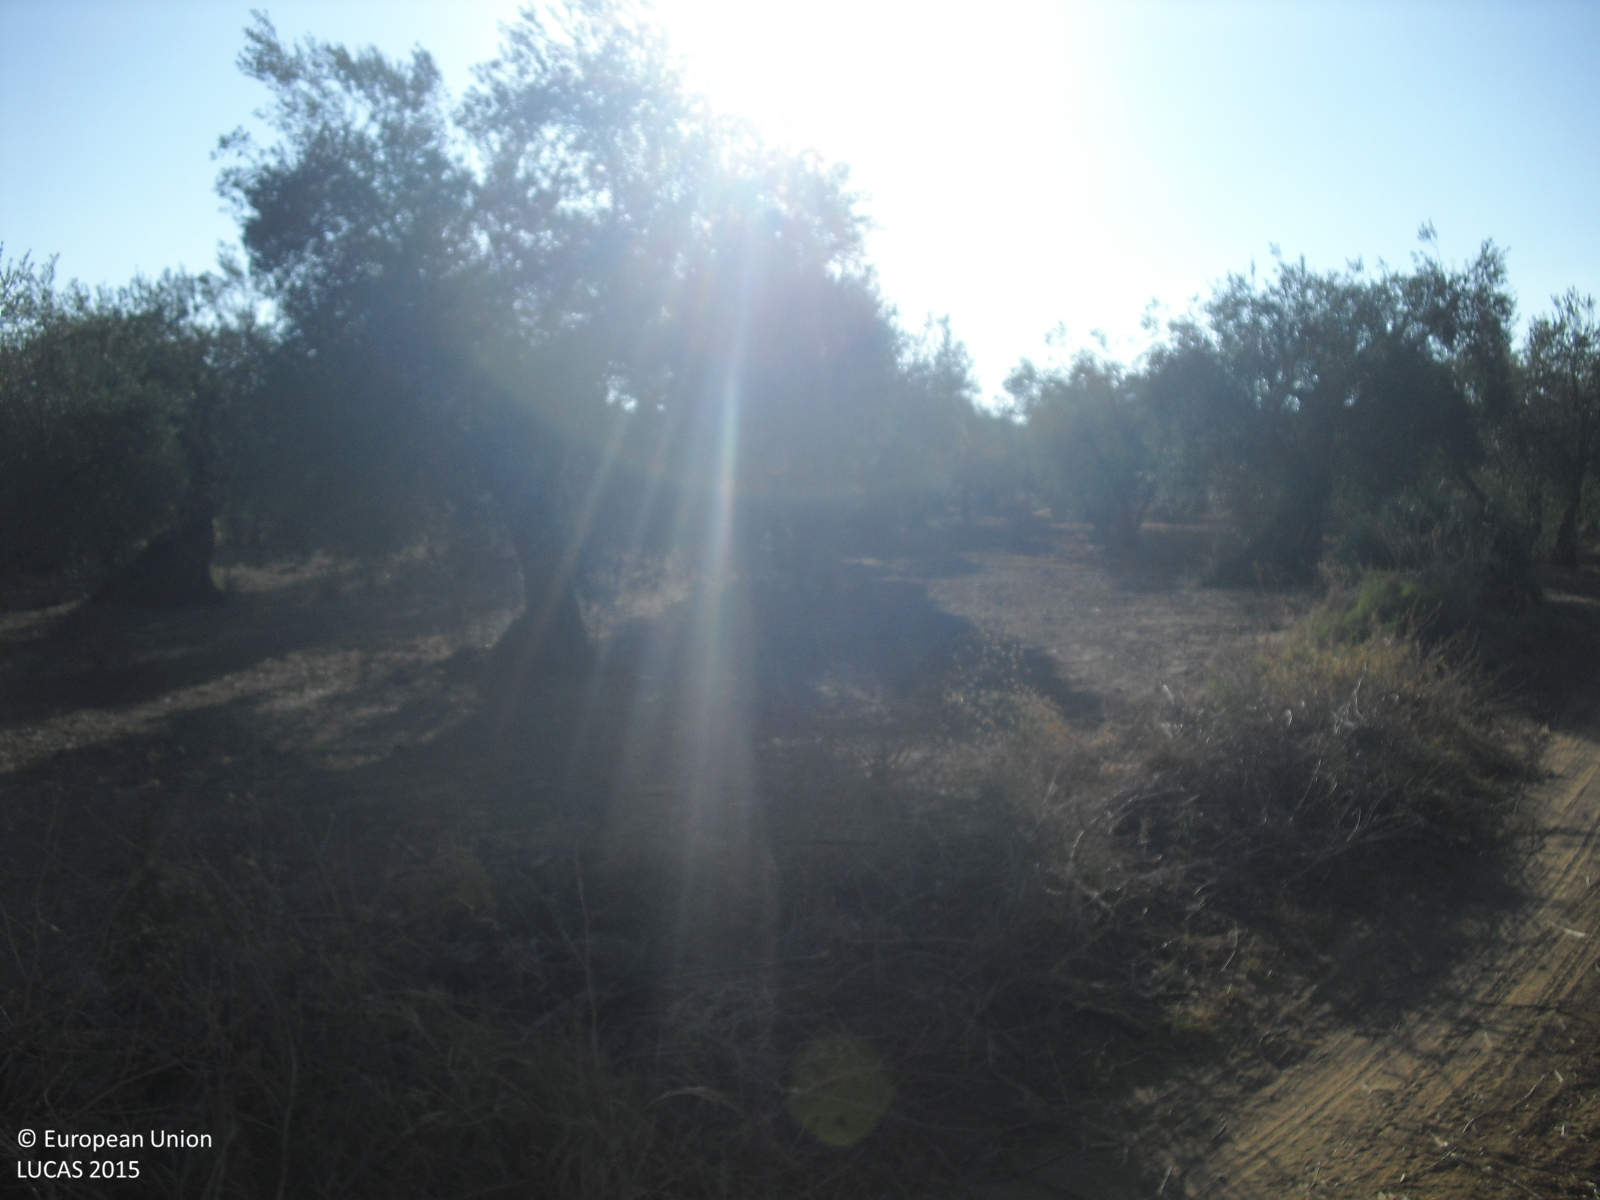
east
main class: Cropland
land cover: Olive groves
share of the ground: 25 - 50 %
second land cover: Other bare soil
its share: > 75 %
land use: Agriculture (excluding fallow land and kitchen gardens)
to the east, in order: Tracks; Grass margins; Olive groves; Other bare soil
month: August
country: ES
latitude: 37.2007
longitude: -5.5271
